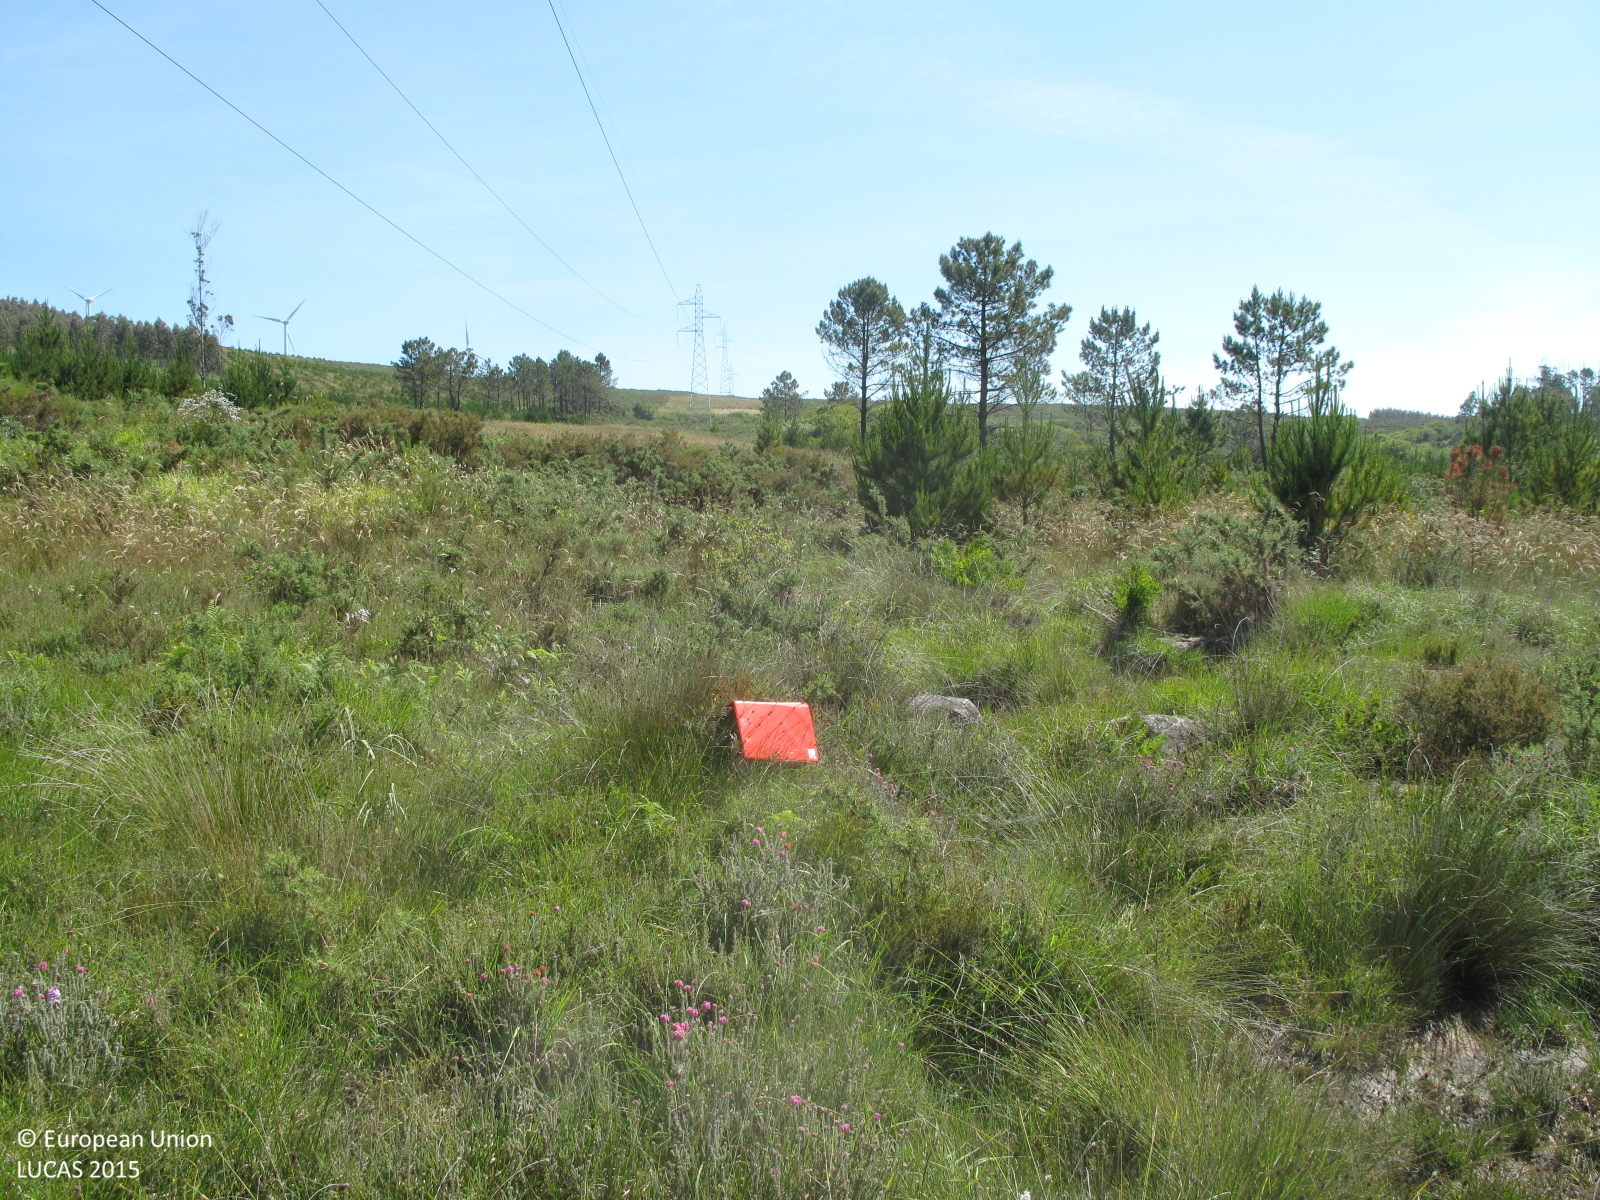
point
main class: Shrubland
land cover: Shrubland with sparse tree cover
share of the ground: 25 - 50 %
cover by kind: herbaceous plants 60 %, shrubs 25 %, lichens and mosses 10 %, coniferous forest trees 5 %
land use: Abandoned areas
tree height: < 5 m
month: June
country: ES
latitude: 43.0762
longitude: -8.6948
